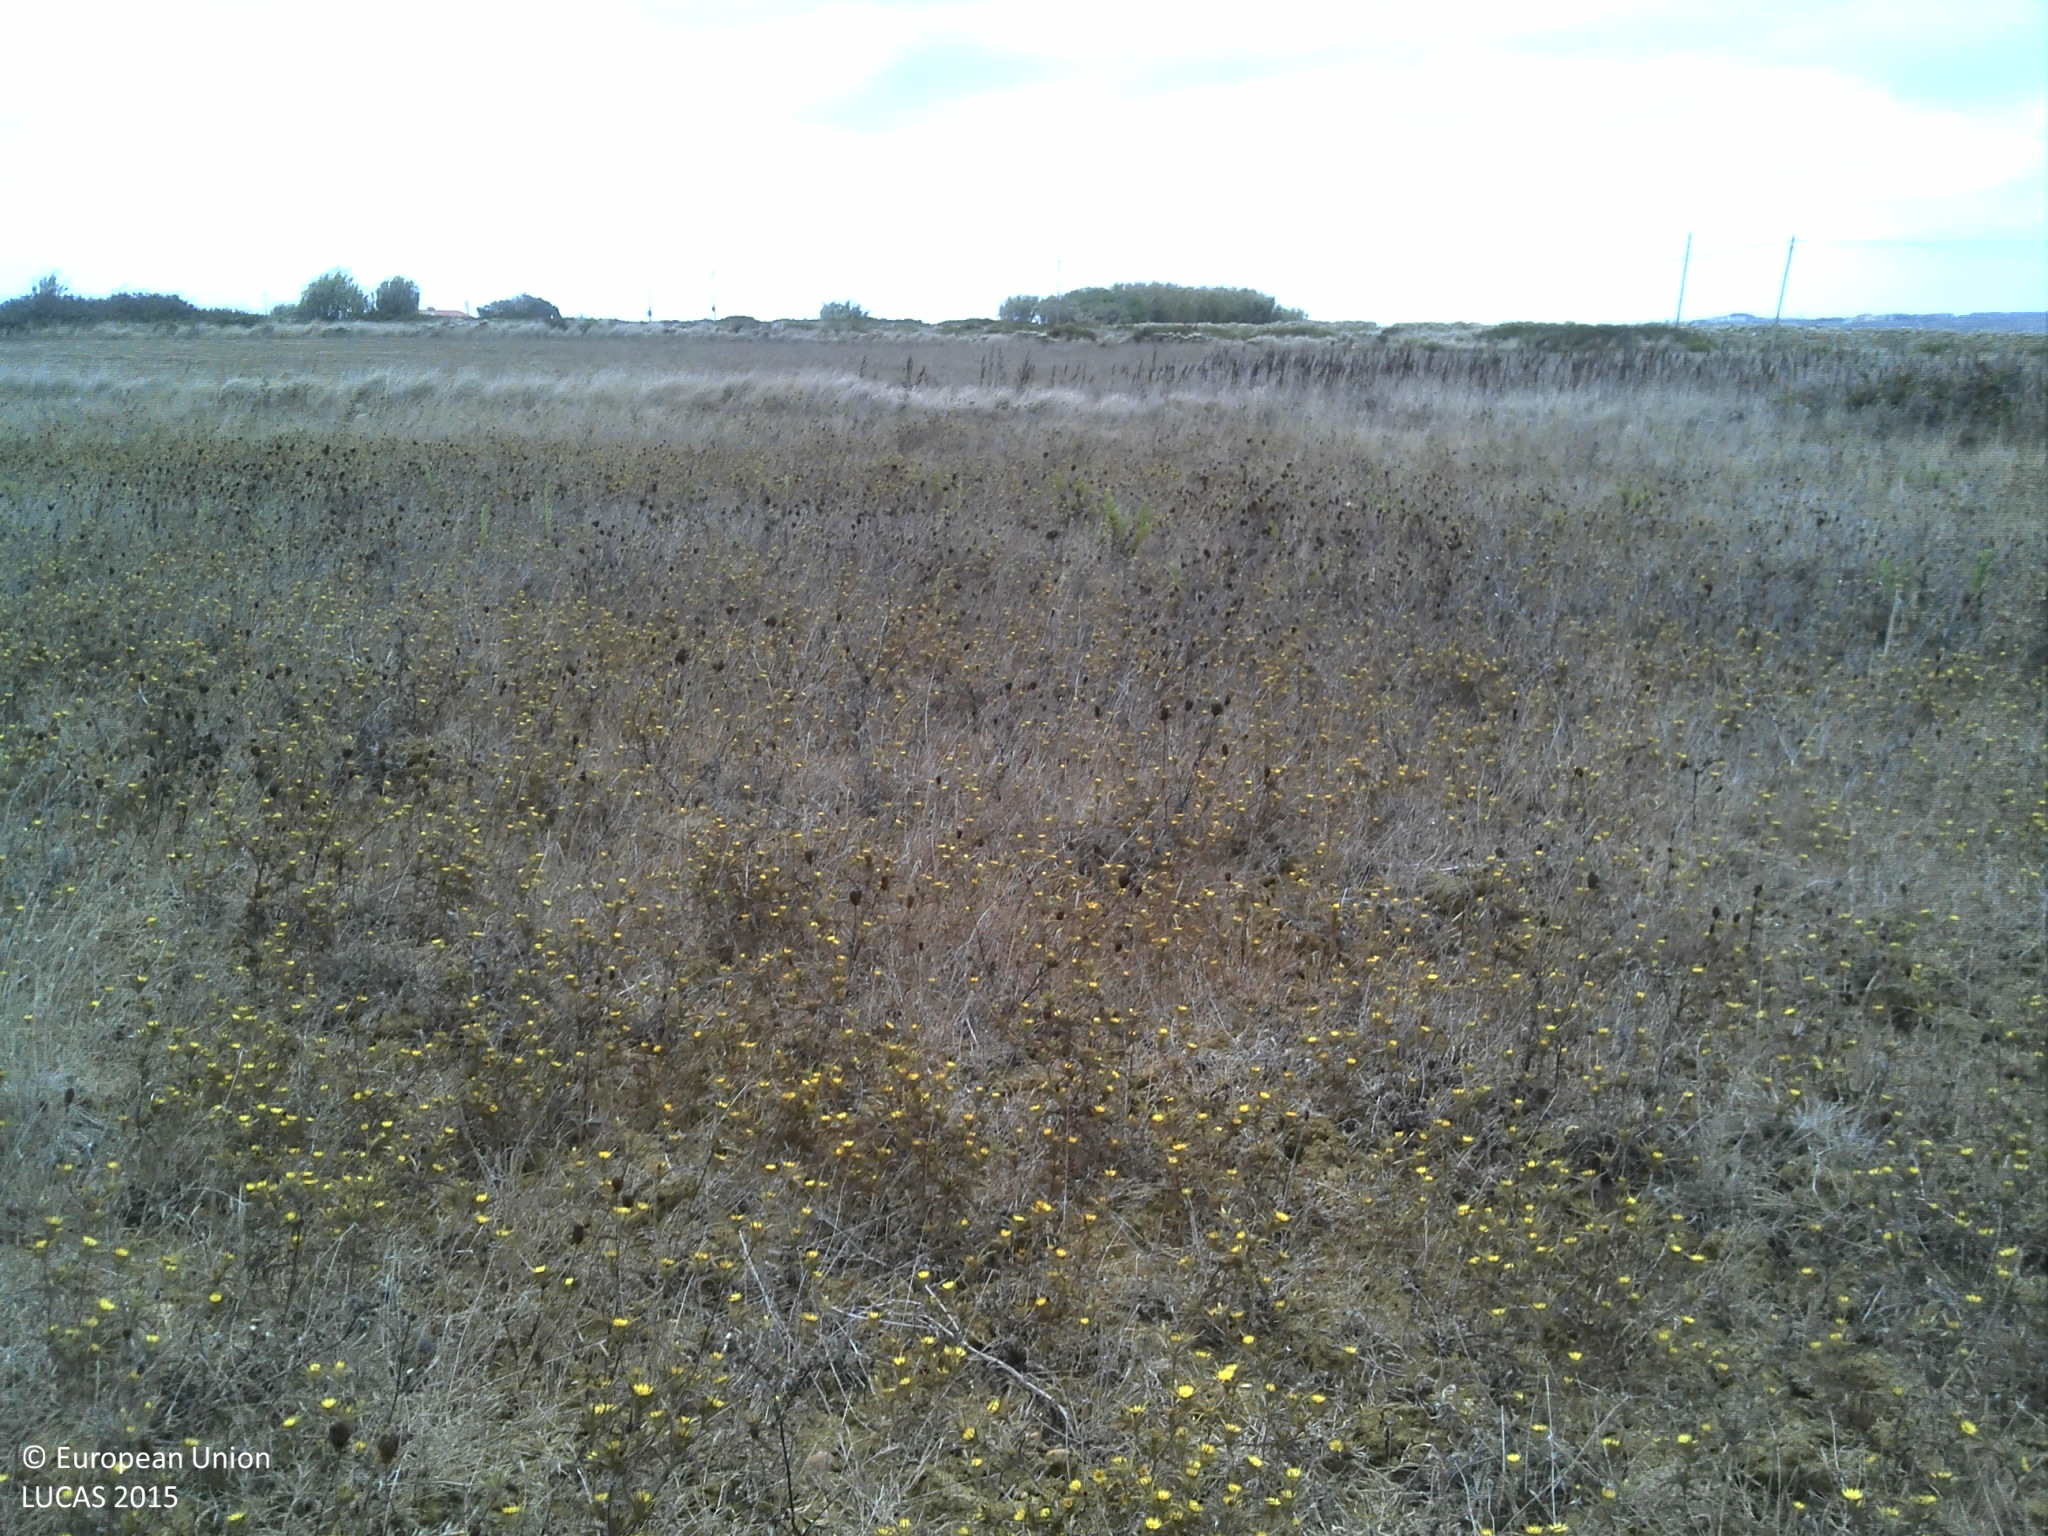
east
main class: Grassland
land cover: Grassland without tree/shrub cover
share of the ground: 25 - 50 %
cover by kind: unconsolidated bare surface 60 %, herbaceous plants 40 %
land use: Agriculture (excluding fallow land and kitchen gardens)
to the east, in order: Grassland without tree/shrub cover; Dry stone walls; Grassland without tree/shrub cover; Dry stone walls; Grassland without tree/shrub cover; Fences; Inland fresh water bodies; Fences; Grassland without tree/shrub cover
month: August
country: PT
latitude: 38.8984
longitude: -9.4234
